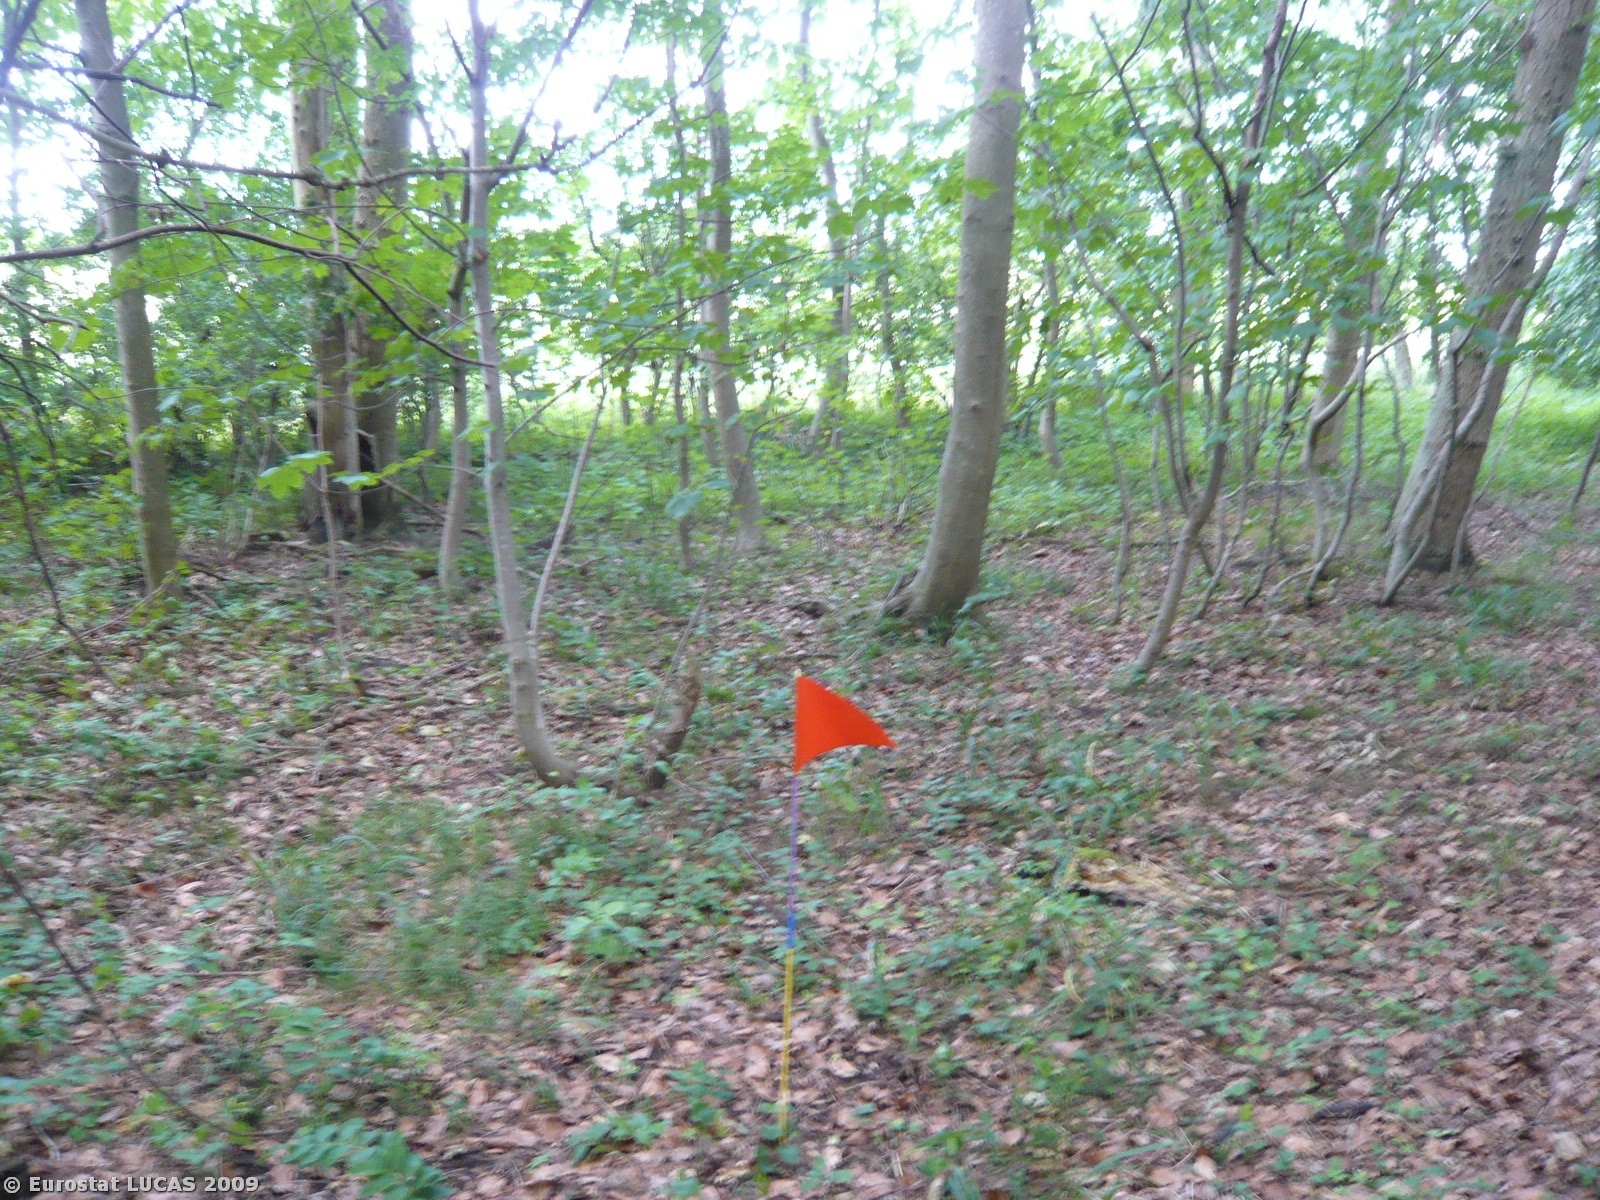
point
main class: Woodland
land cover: Broadleaved woodland
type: mesophytic deciduous forest
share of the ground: > 75 %
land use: Forestry
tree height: > 5 m
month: July
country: DK
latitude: 55.3774
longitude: 10.6149
